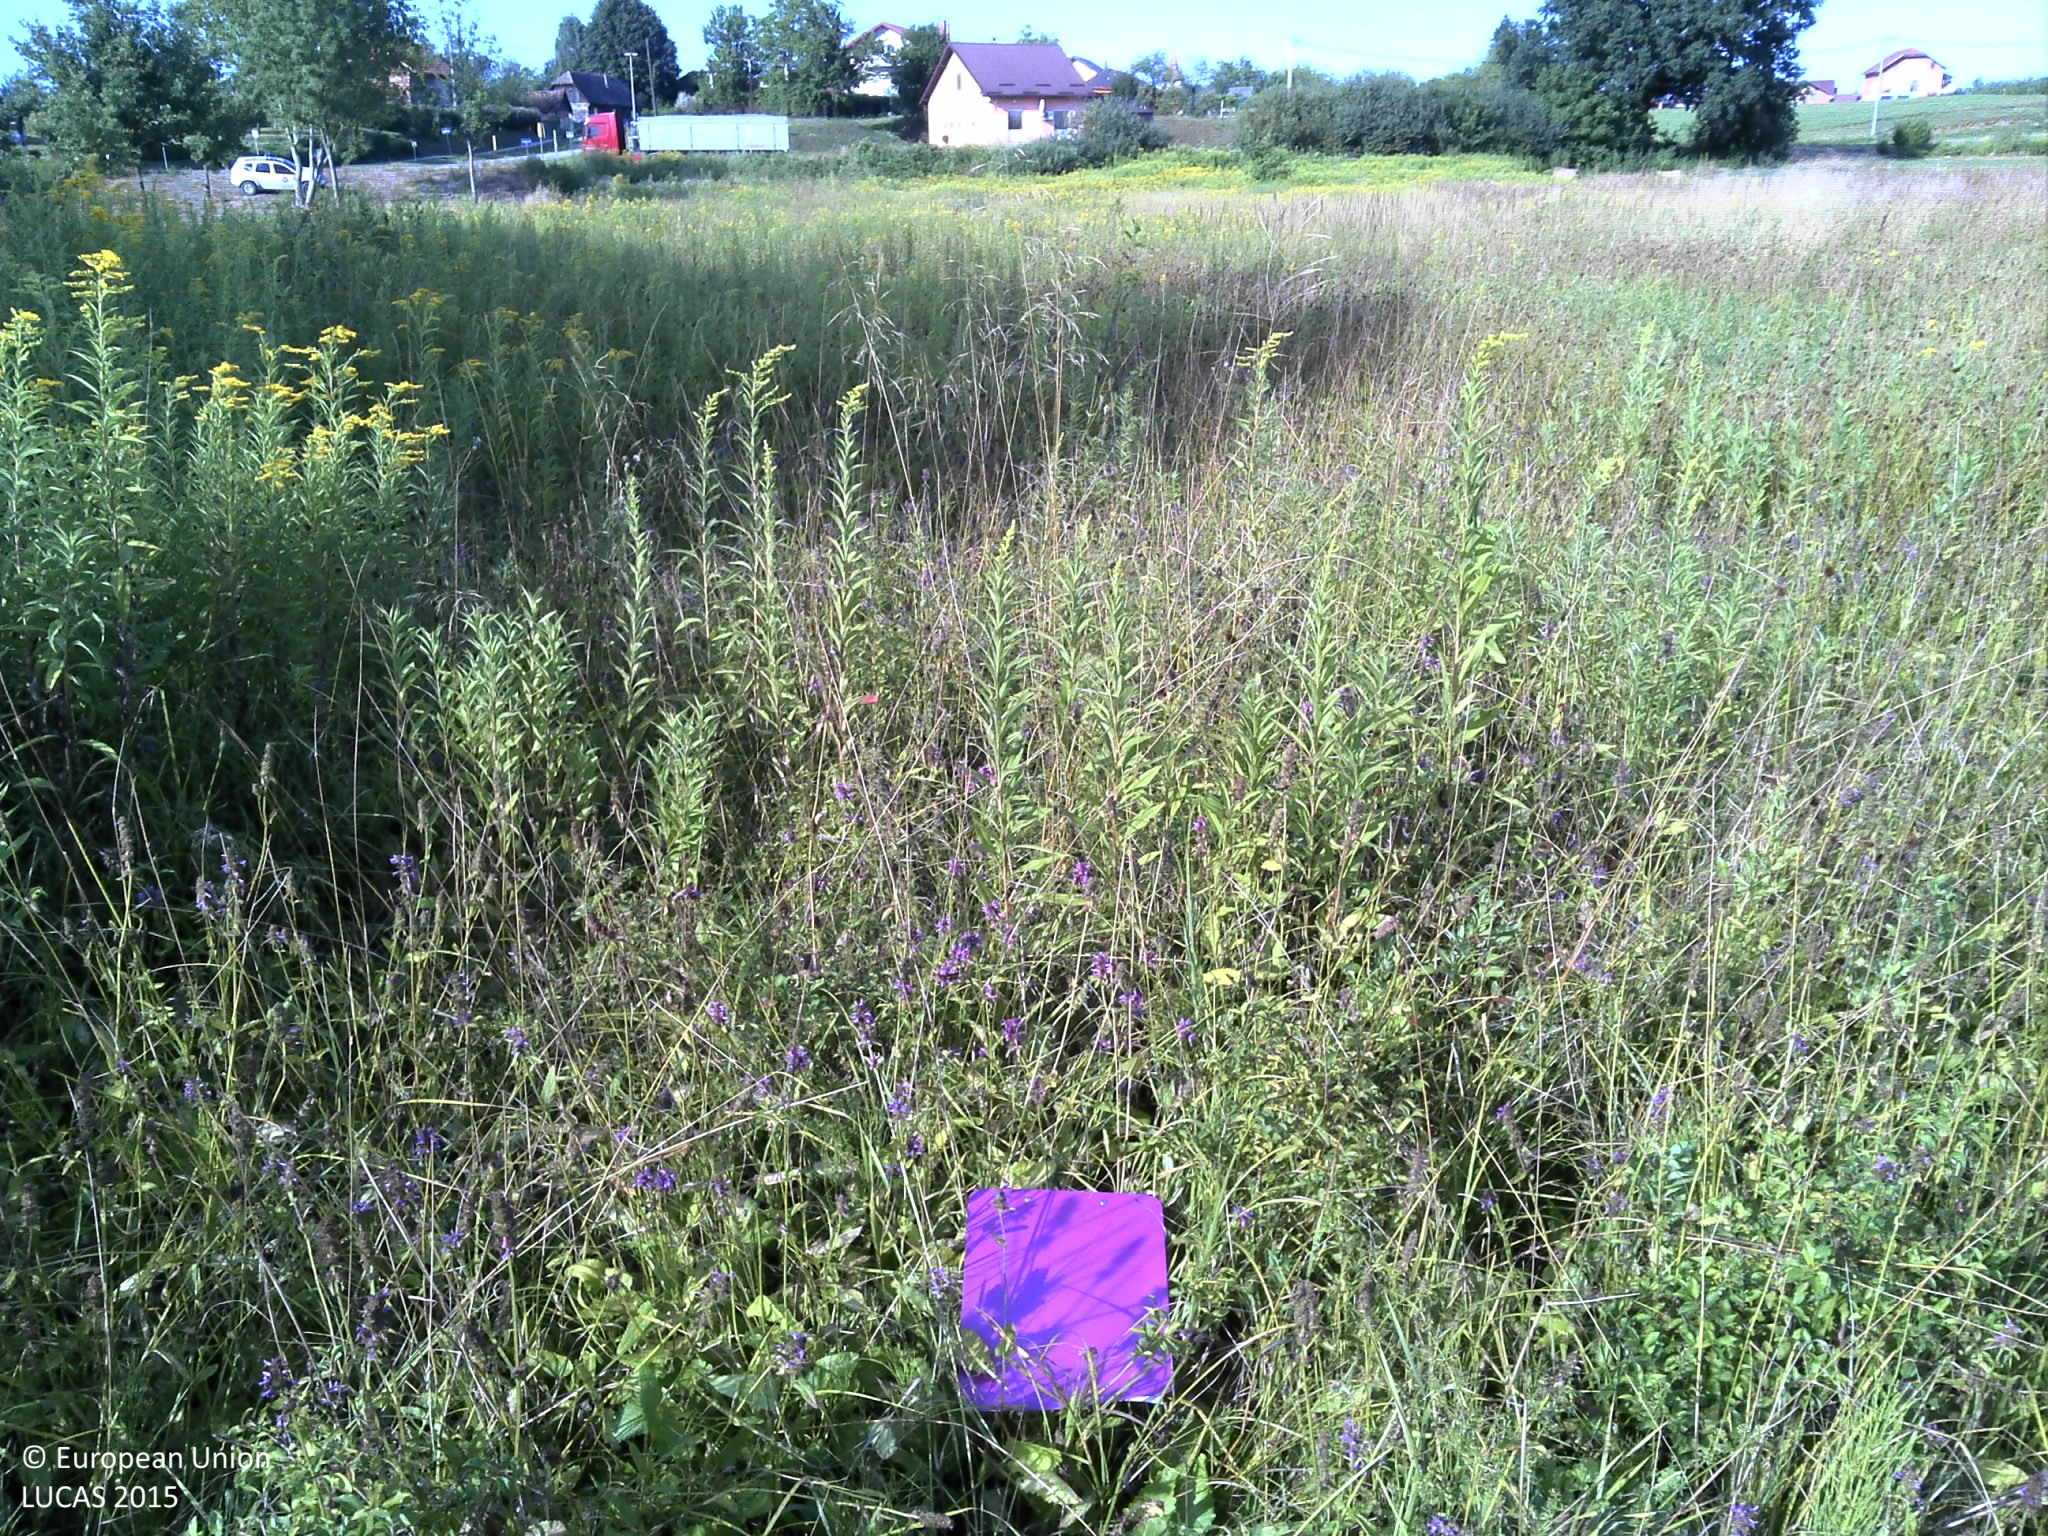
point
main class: Grassland
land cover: Grassland without tree/shrub cover
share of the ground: > 75 %
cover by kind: herbaceous plants 100 %
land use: Agriculture (excluding fallow land and kitchen gardens)
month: July
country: HR
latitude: 45.6066
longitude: 16.5764
